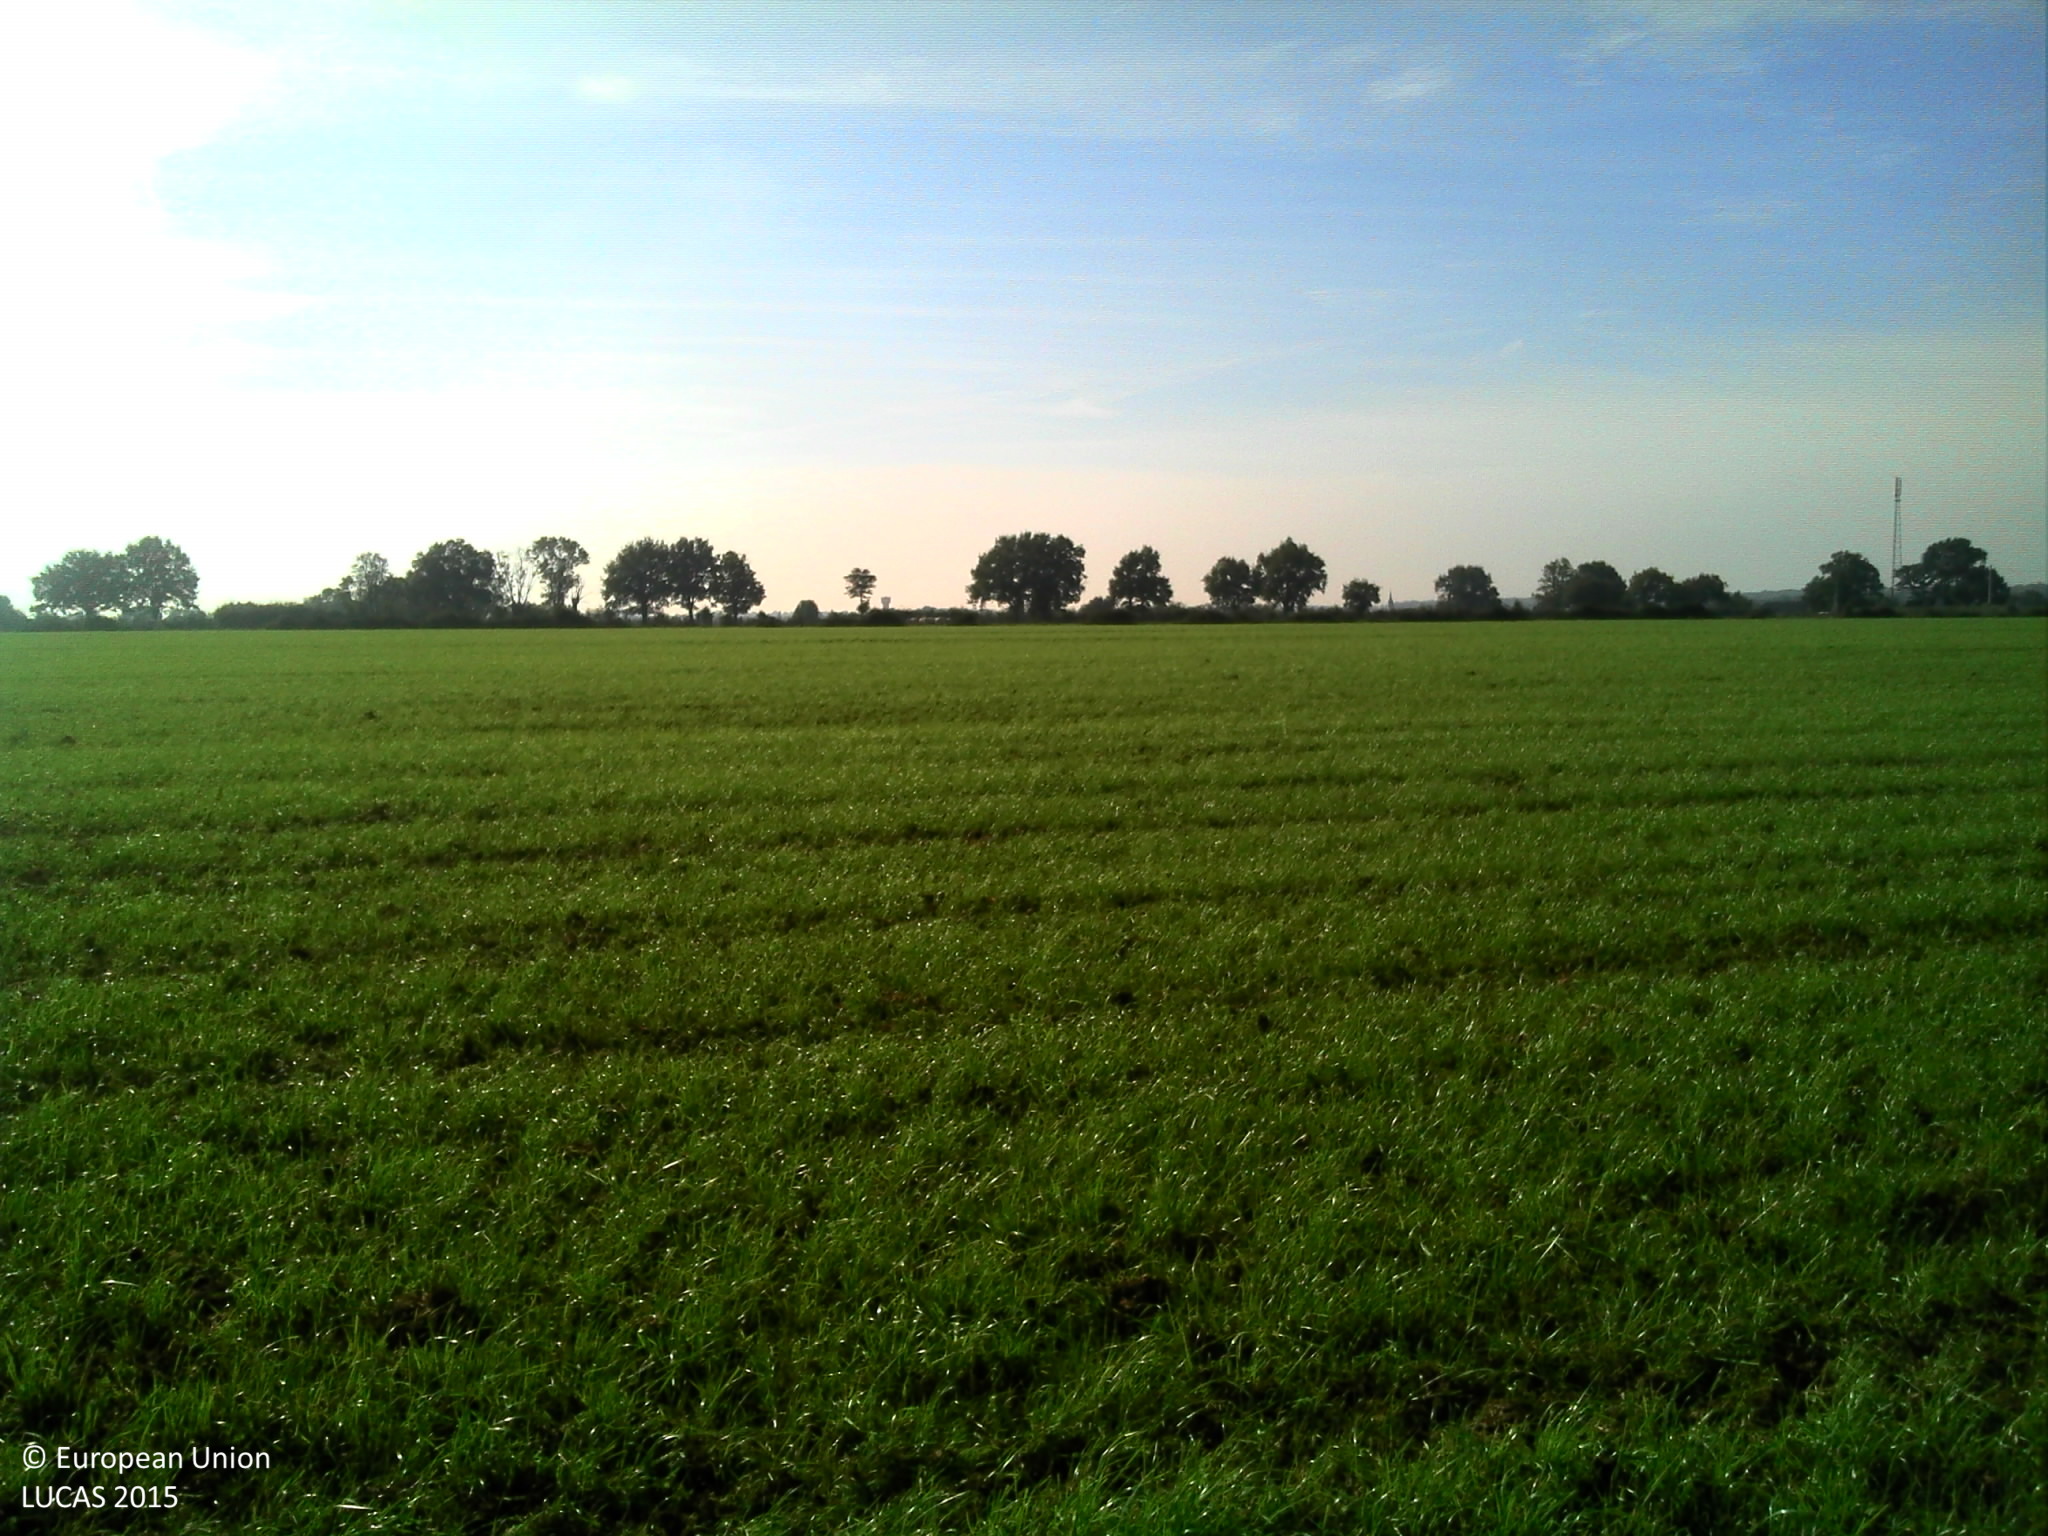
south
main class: Cropland
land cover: Temporary grasslands
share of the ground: > 75 %
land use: Agriculture (excluding fallow land and kitchen gardens)
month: October
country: FR
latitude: 47.1862
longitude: -0.9485
